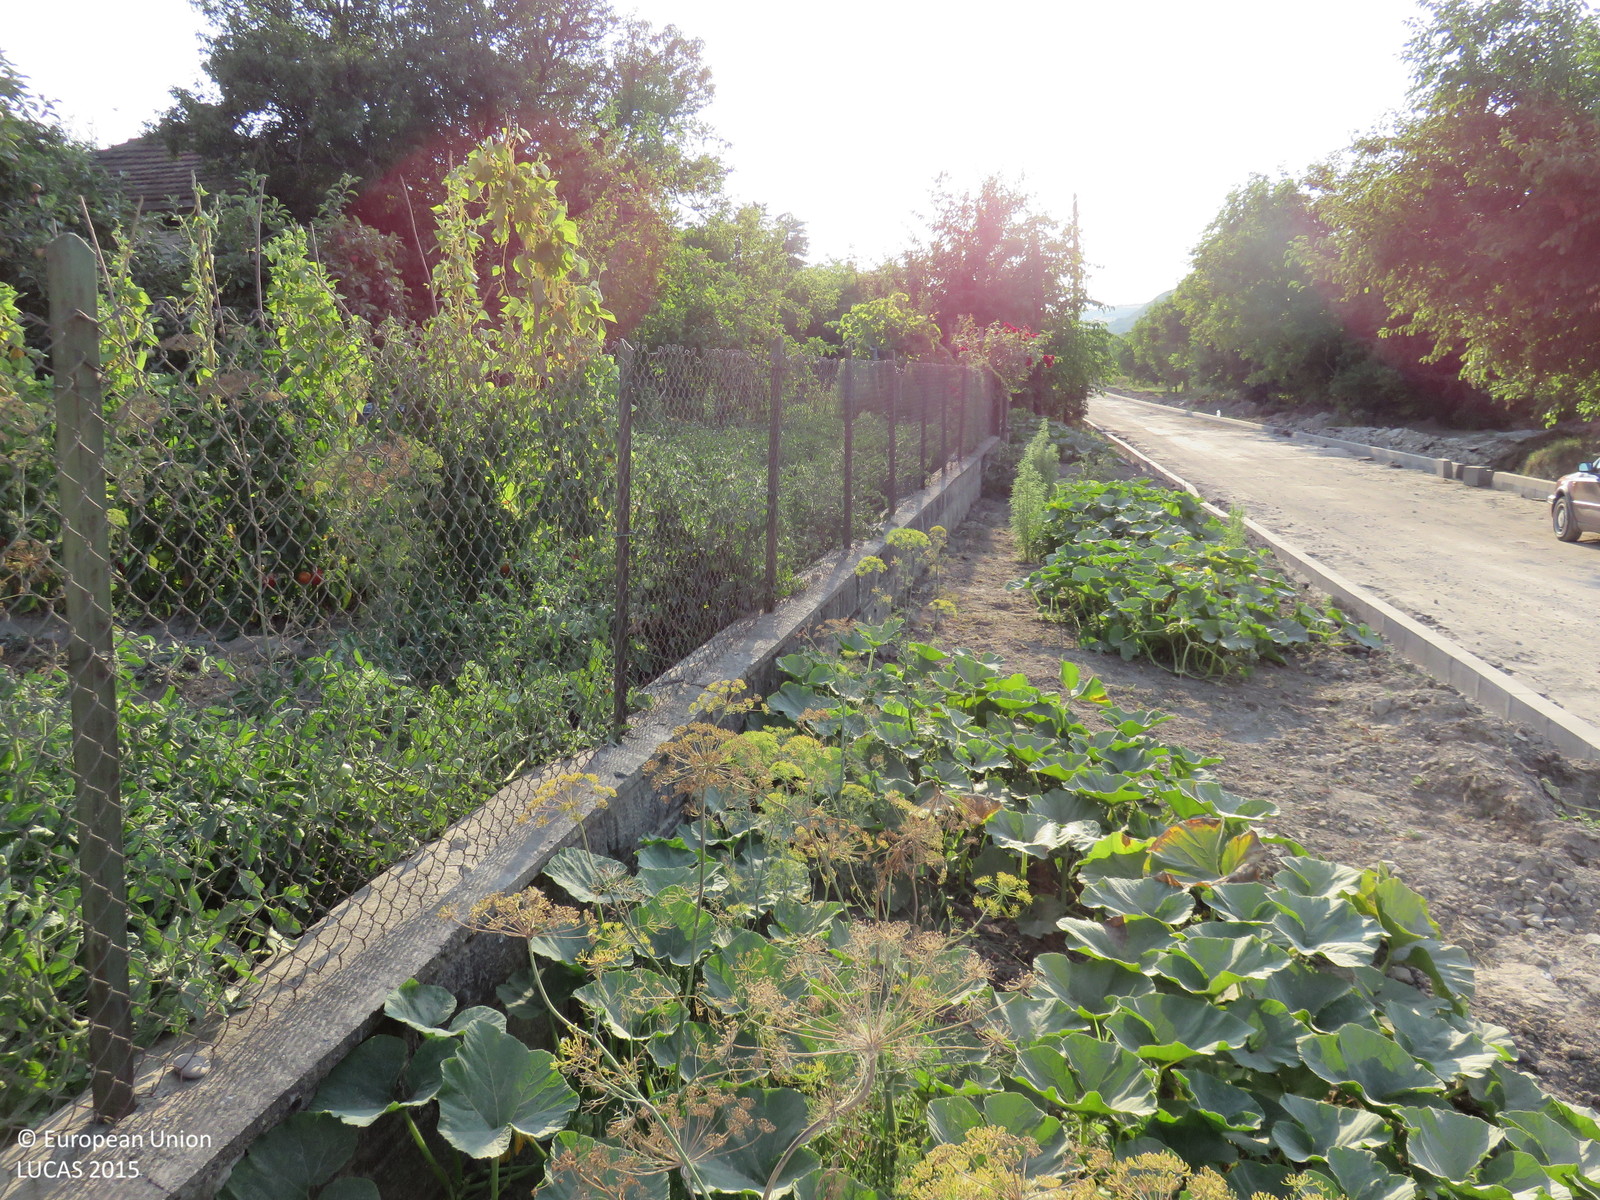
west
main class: Cropland
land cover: Vineyards
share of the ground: 50 - 75 %
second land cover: Other bare soil
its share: > 75 %
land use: Kitchen garden
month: July
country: BG
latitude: 43.6327
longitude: 25.0336
